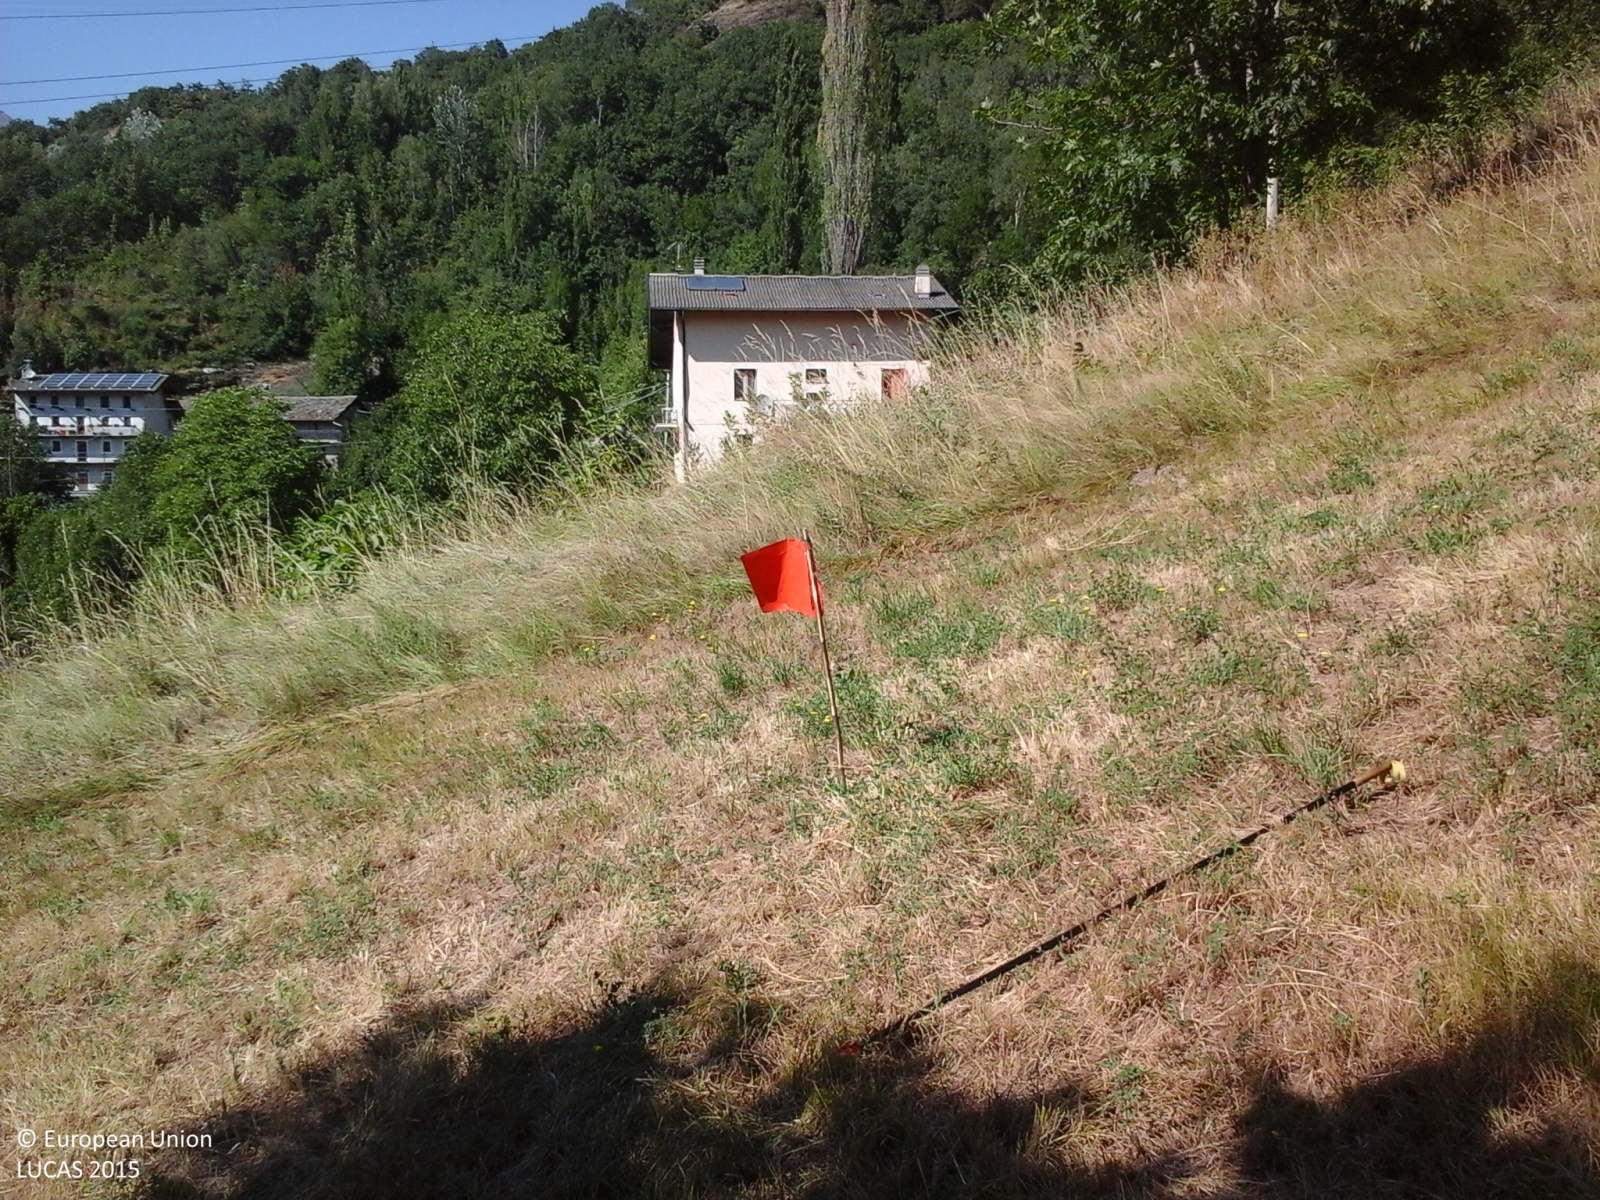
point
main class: Grassland
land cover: Grassland with sparse tree/shrub cover
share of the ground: > 75 %
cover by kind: herbaceous plants 95 %, broadleaved forest trees 5 %
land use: Agriculture (excluding fallow land and kitchen gardens)
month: July
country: IT
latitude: 45.6952
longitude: 7.6789
